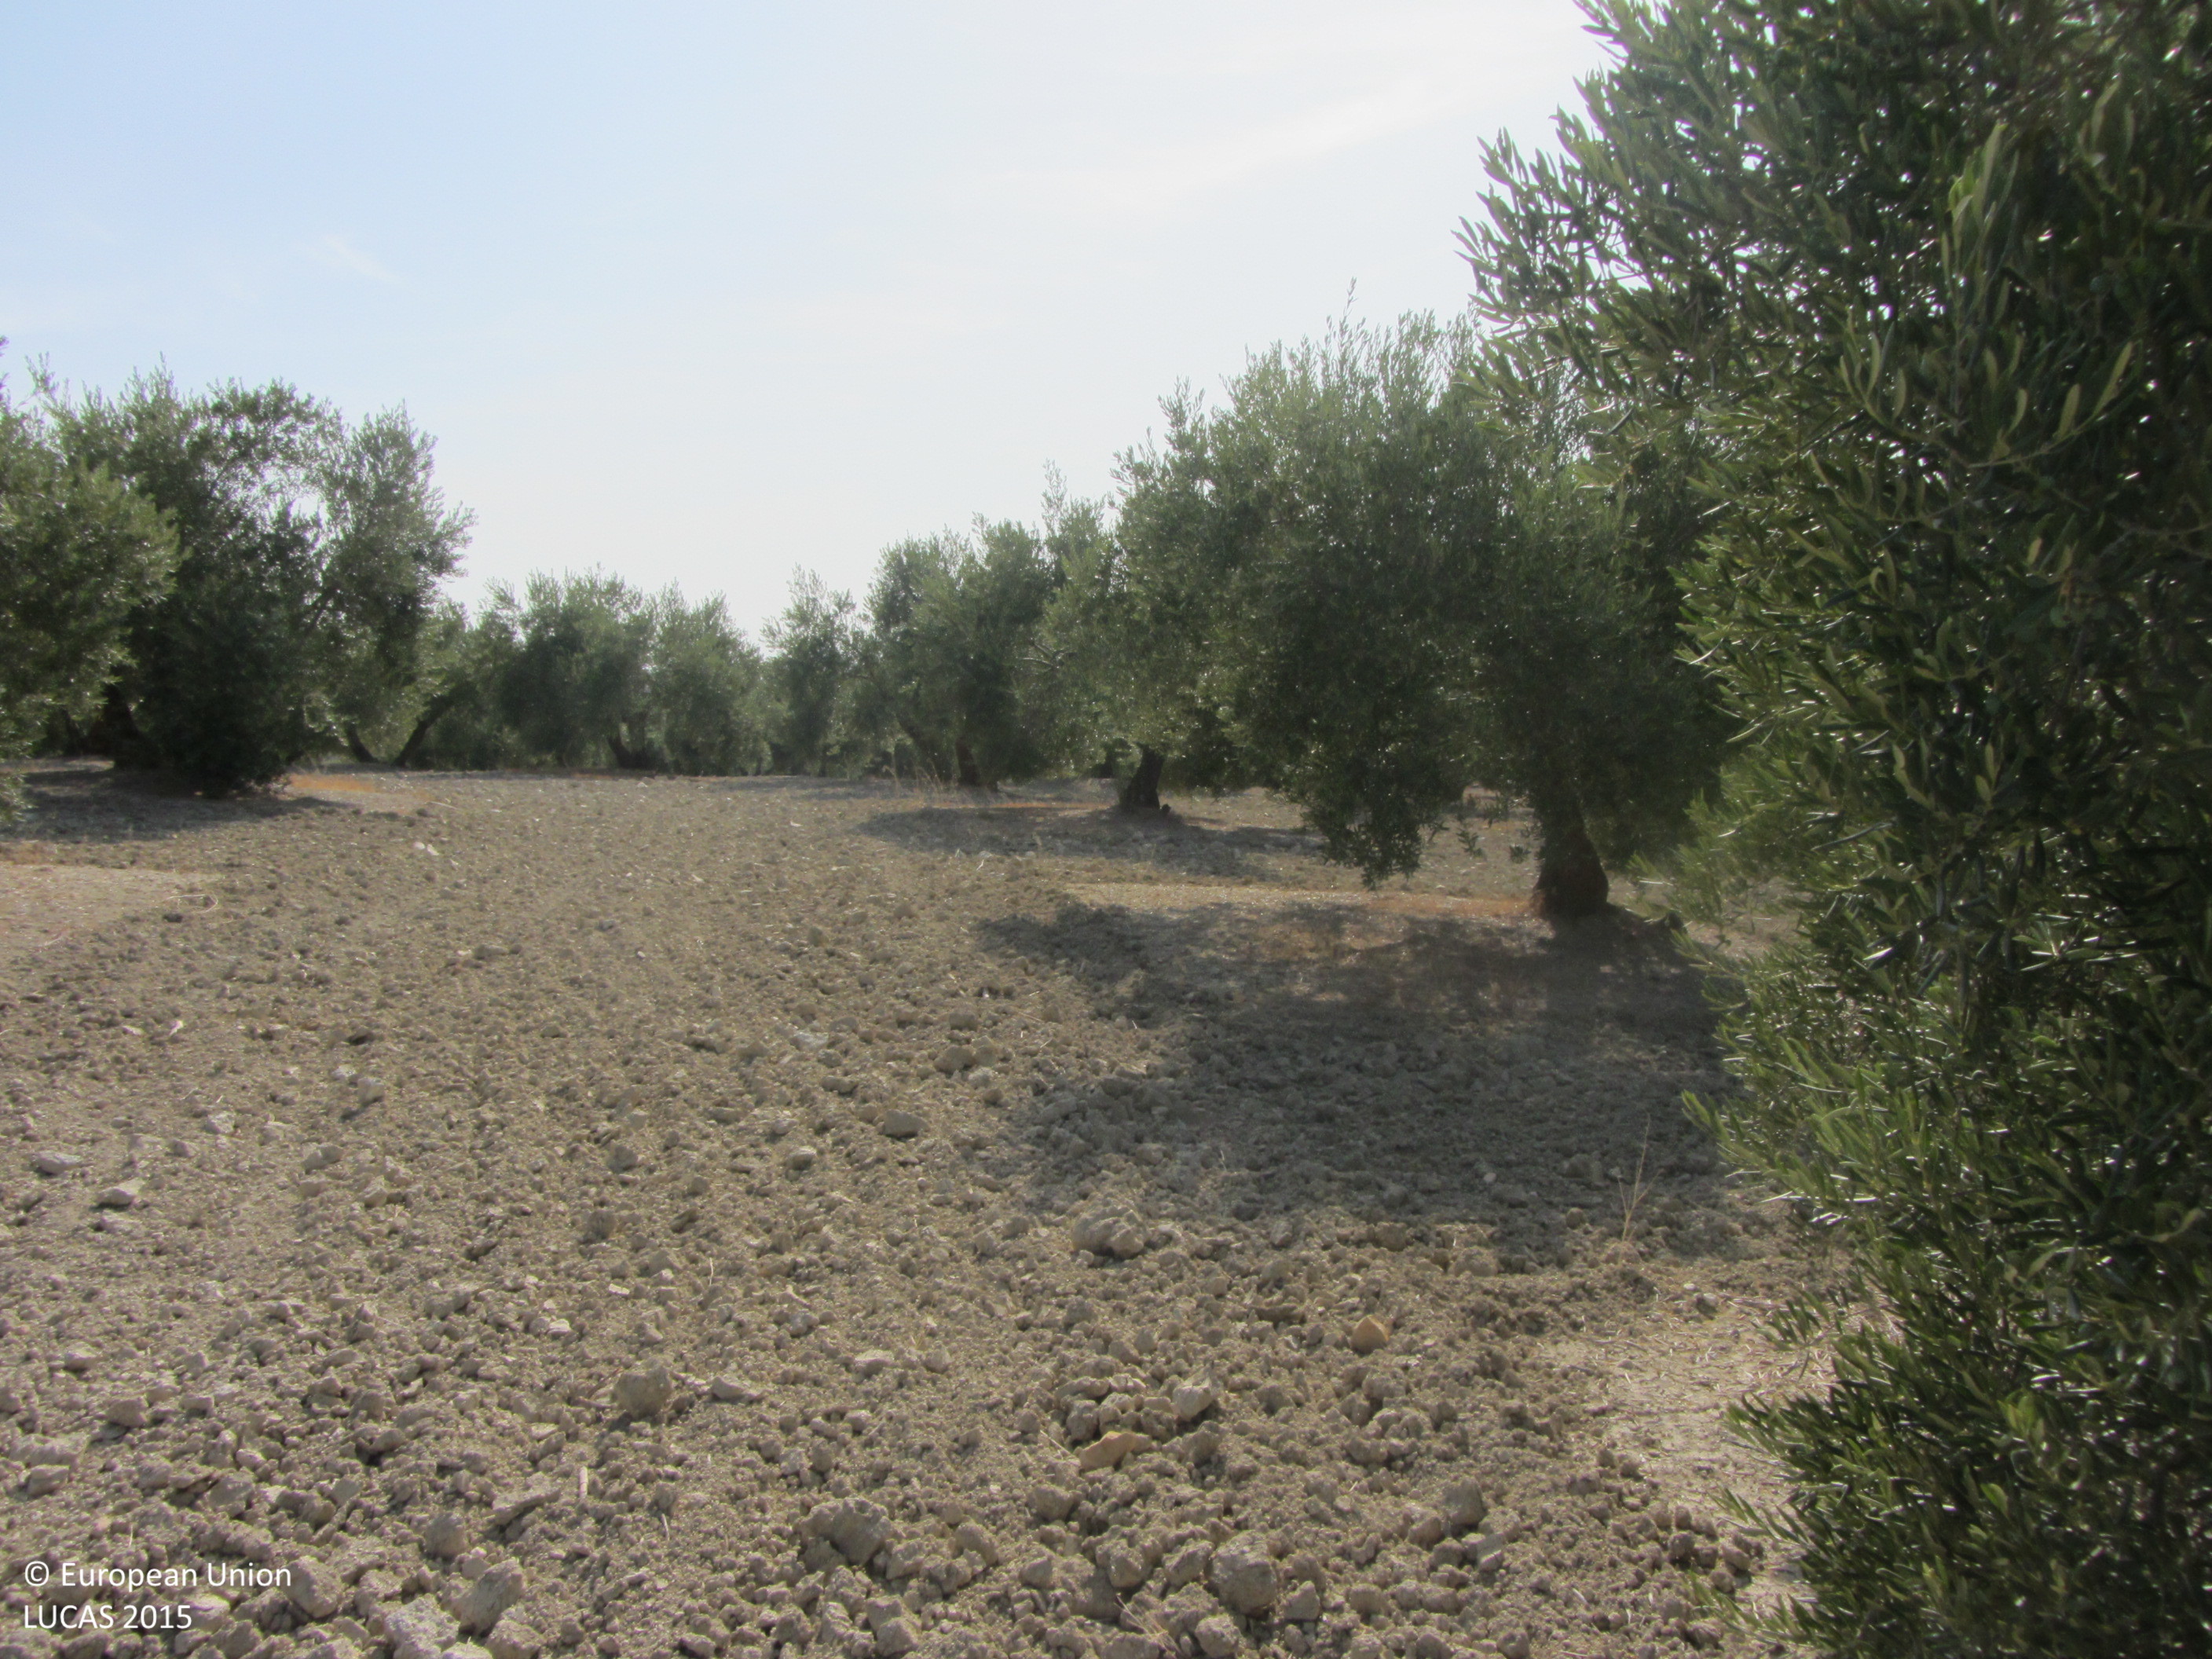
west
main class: Cropland
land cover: Olive groves
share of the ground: 25 - 50 %
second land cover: Other bare soil
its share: > 75 %
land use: Agriculture (excluding fallow land and kitchen gardens)
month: July
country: ES
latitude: 37.7561
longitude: -4.2274
